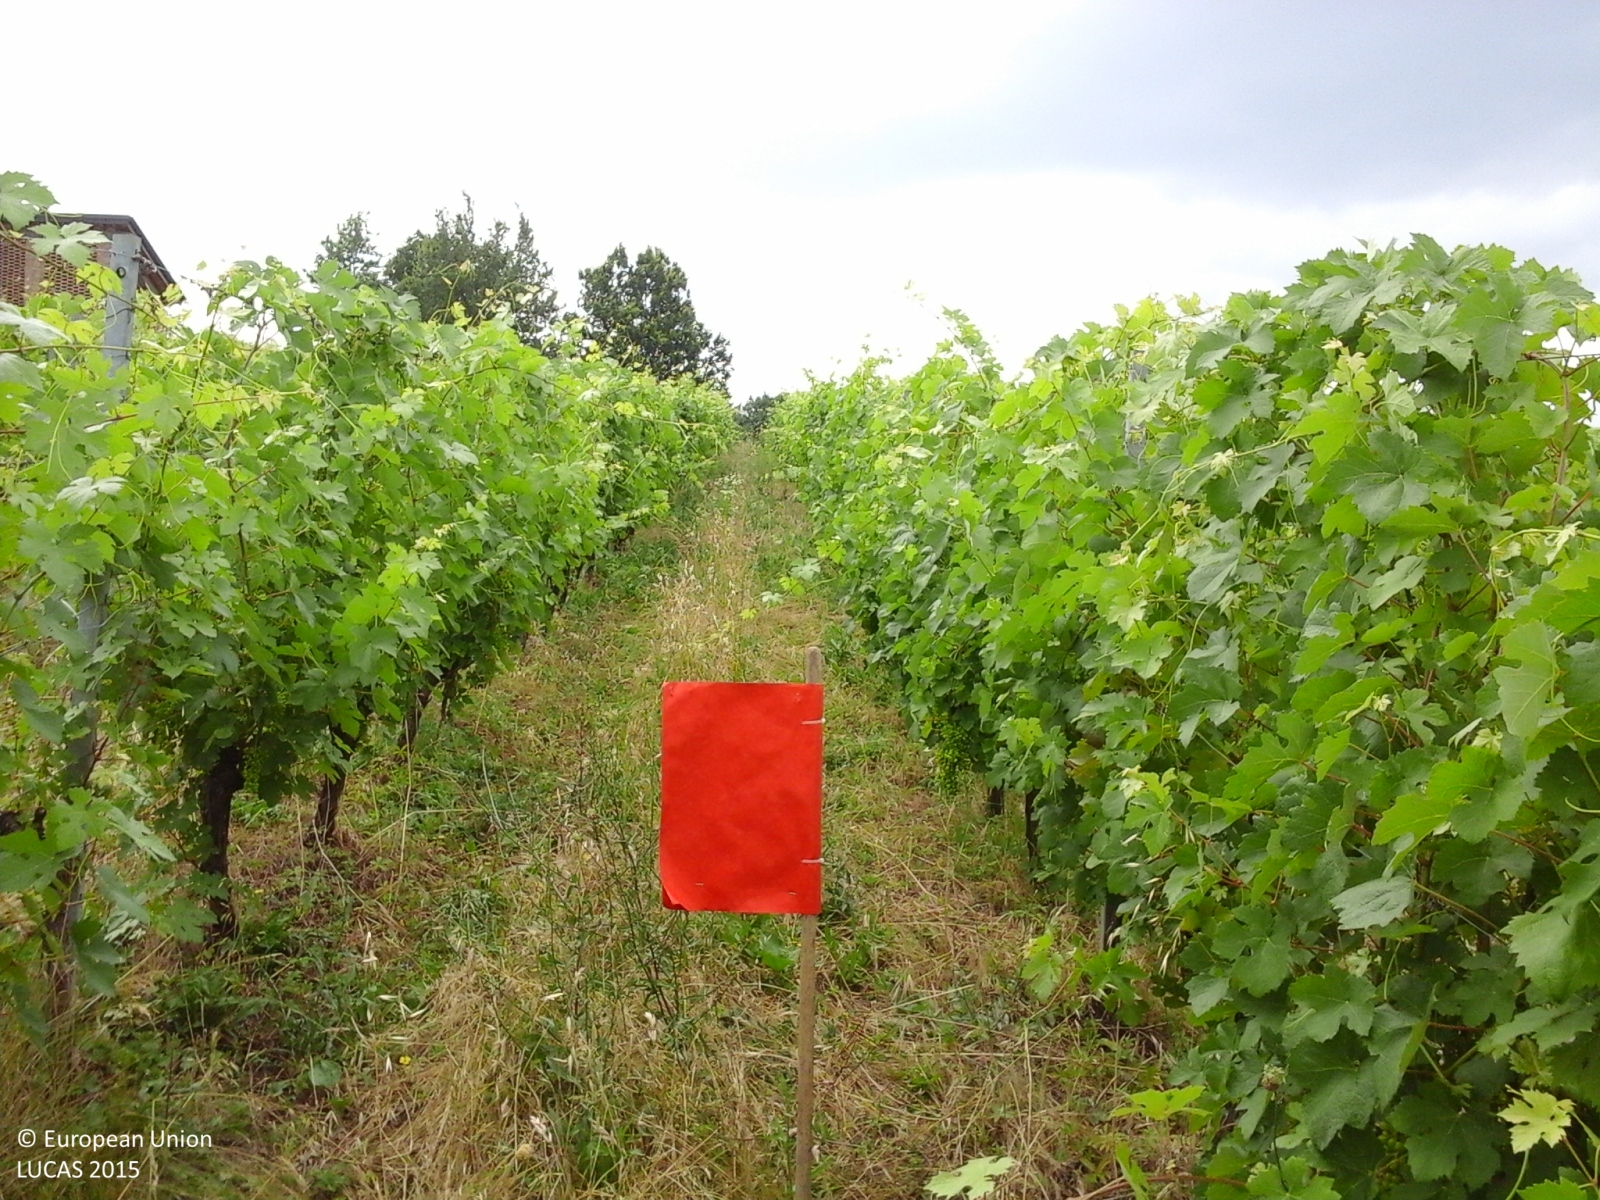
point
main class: Cropland
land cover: Vineyards
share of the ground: 10 - 25 %
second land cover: Grassland without tree/shrub cover
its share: > 75 %
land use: Agriculture (excluding fallow land and kitchen gardens)
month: June
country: IT
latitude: 44.8554
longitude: 9.8611
